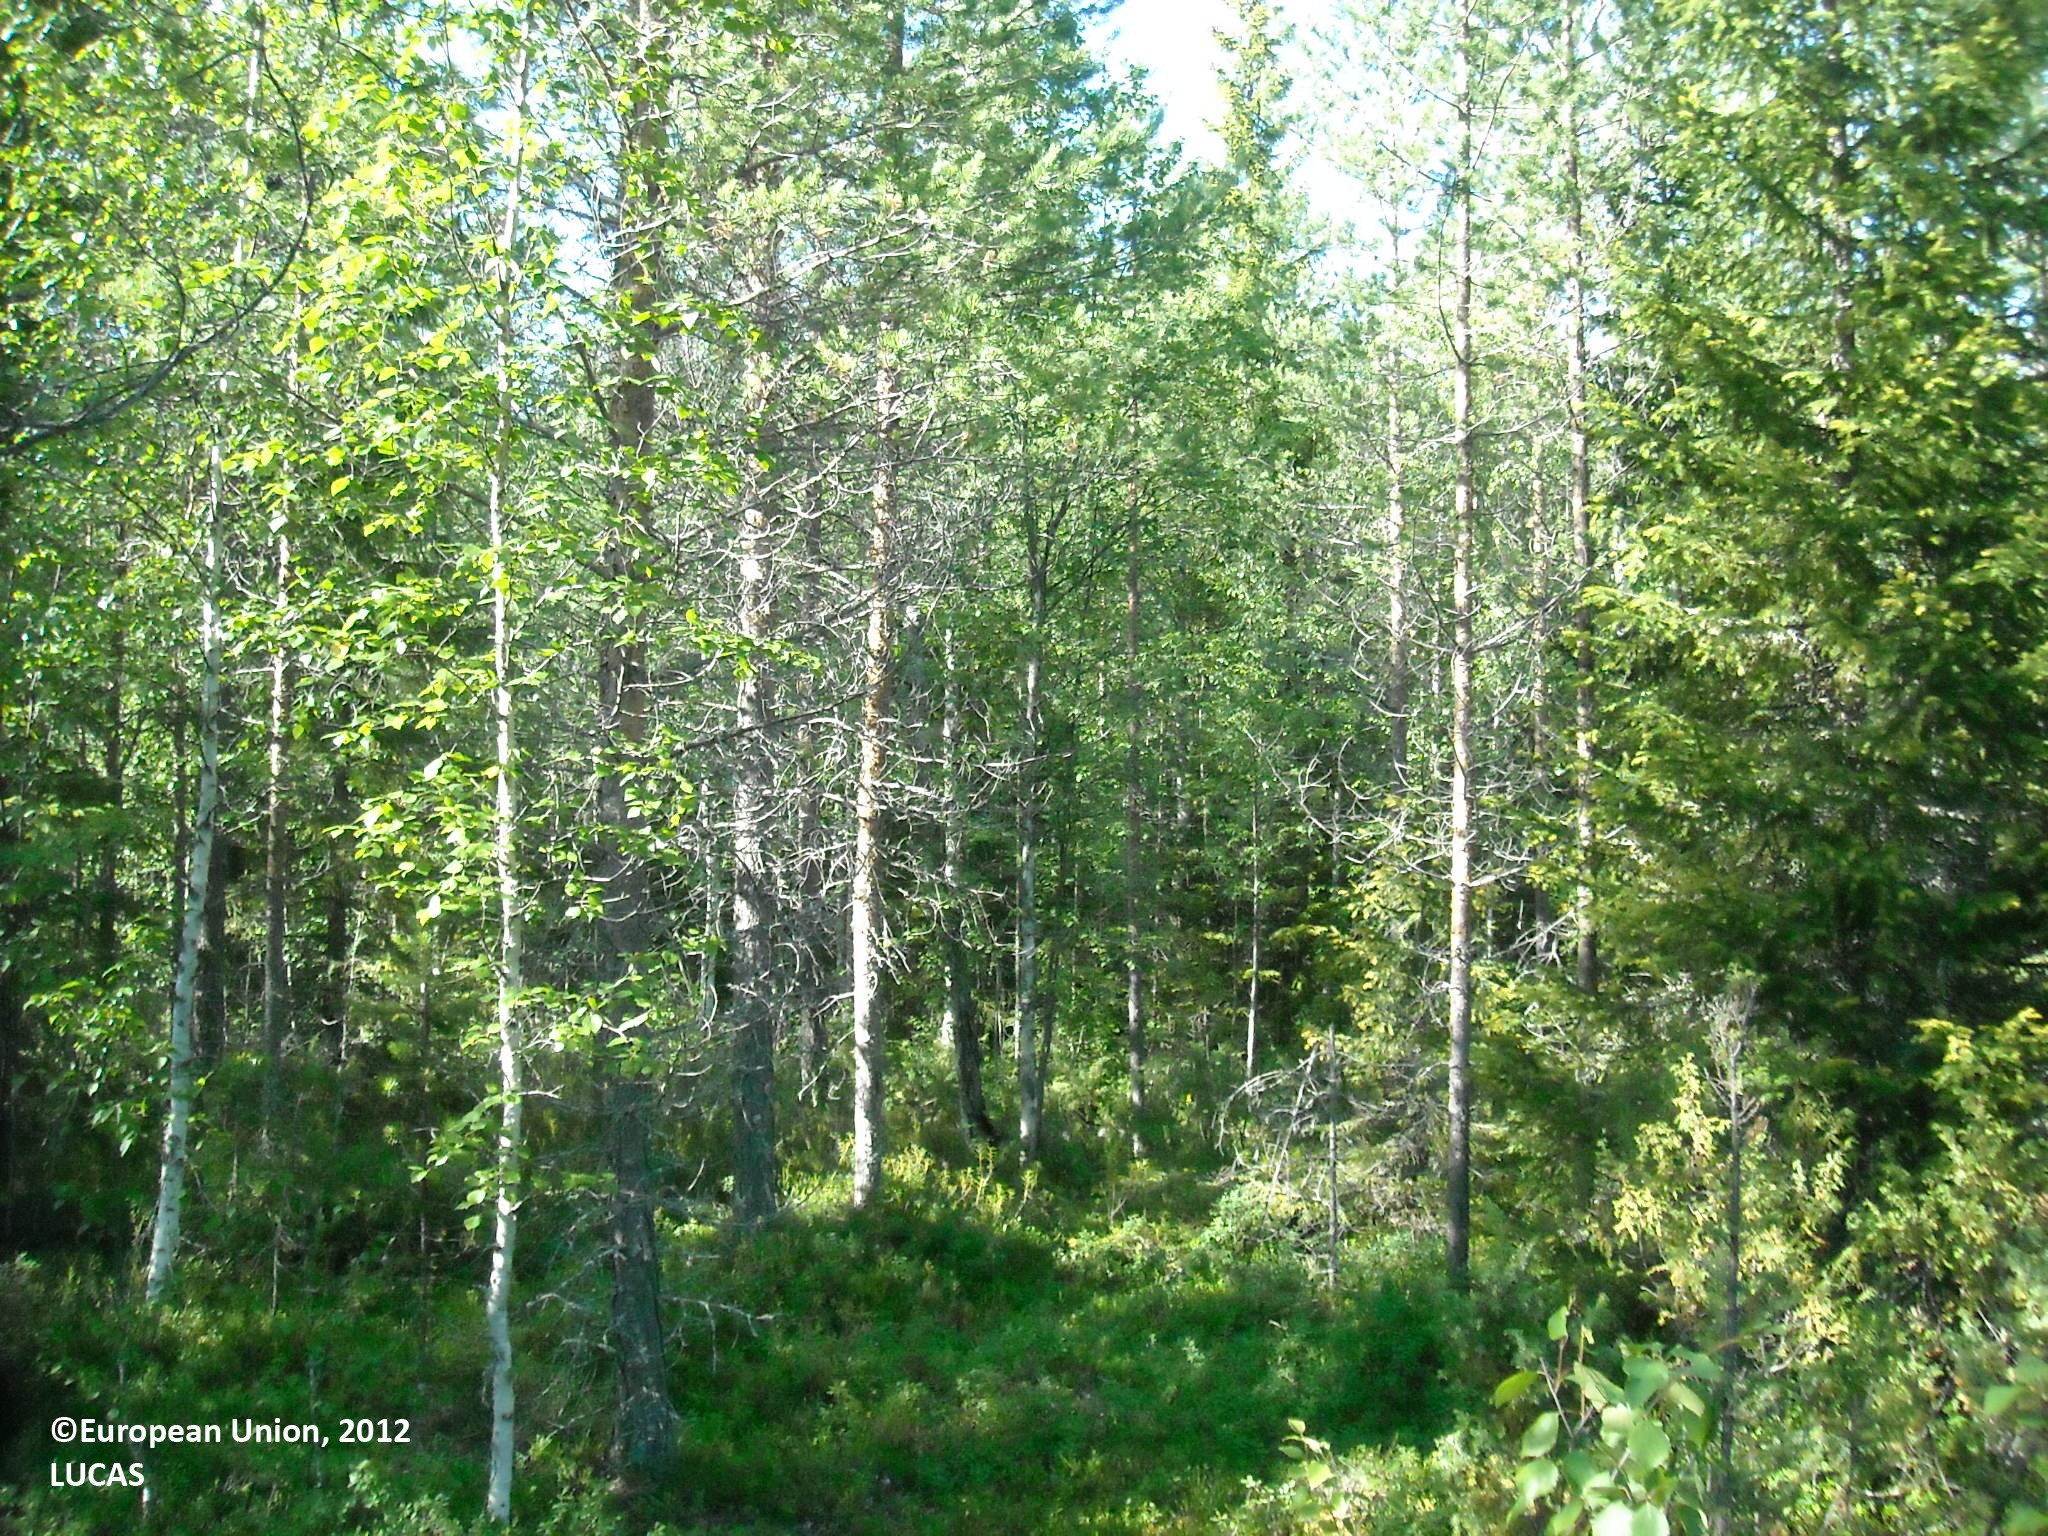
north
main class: Woodland
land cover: Other mixed woodland
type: boreal forest
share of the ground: 50 - 75 %
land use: Forestry
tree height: > 5 m
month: July
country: FI
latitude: 65.1731
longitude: 27.7511
